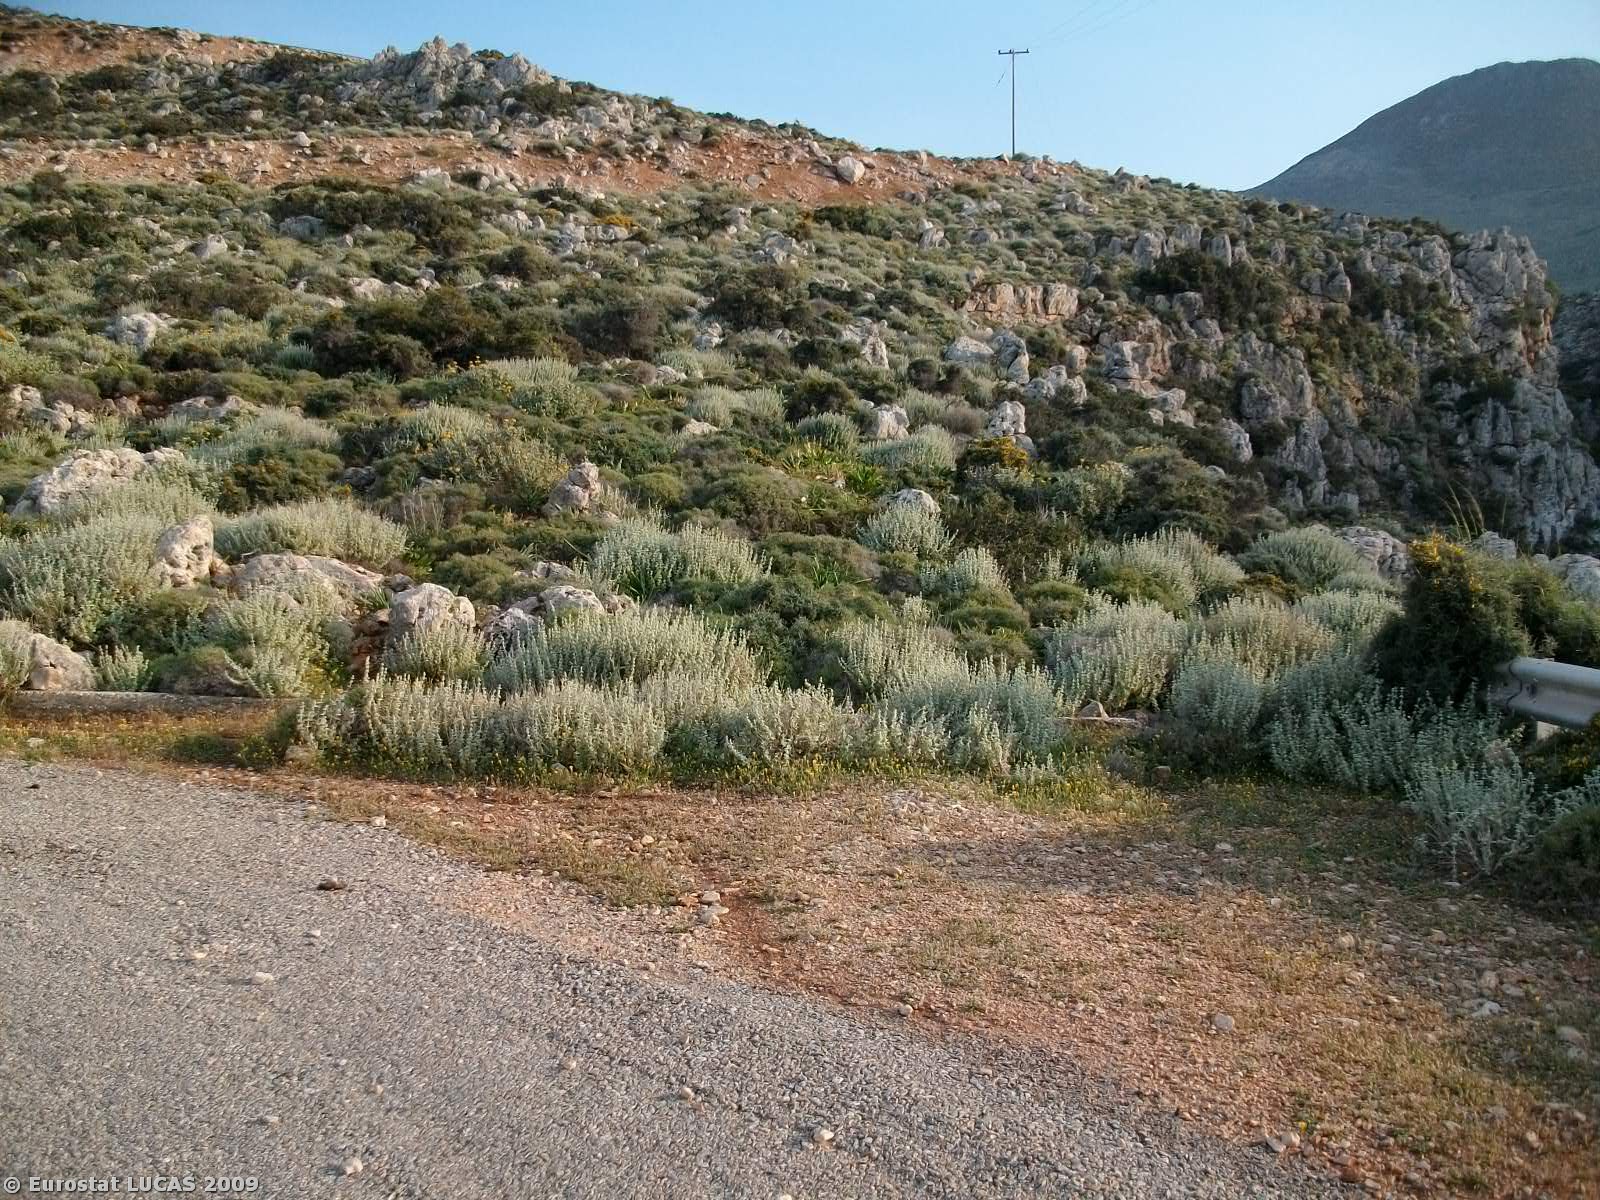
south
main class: Shrubland
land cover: Shrubland without tree cover
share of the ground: > 75 %
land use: Agriculture (excluding fallow land and kitchen gardens)
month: May
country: GR
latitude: 35.4533
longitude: 24.2551
